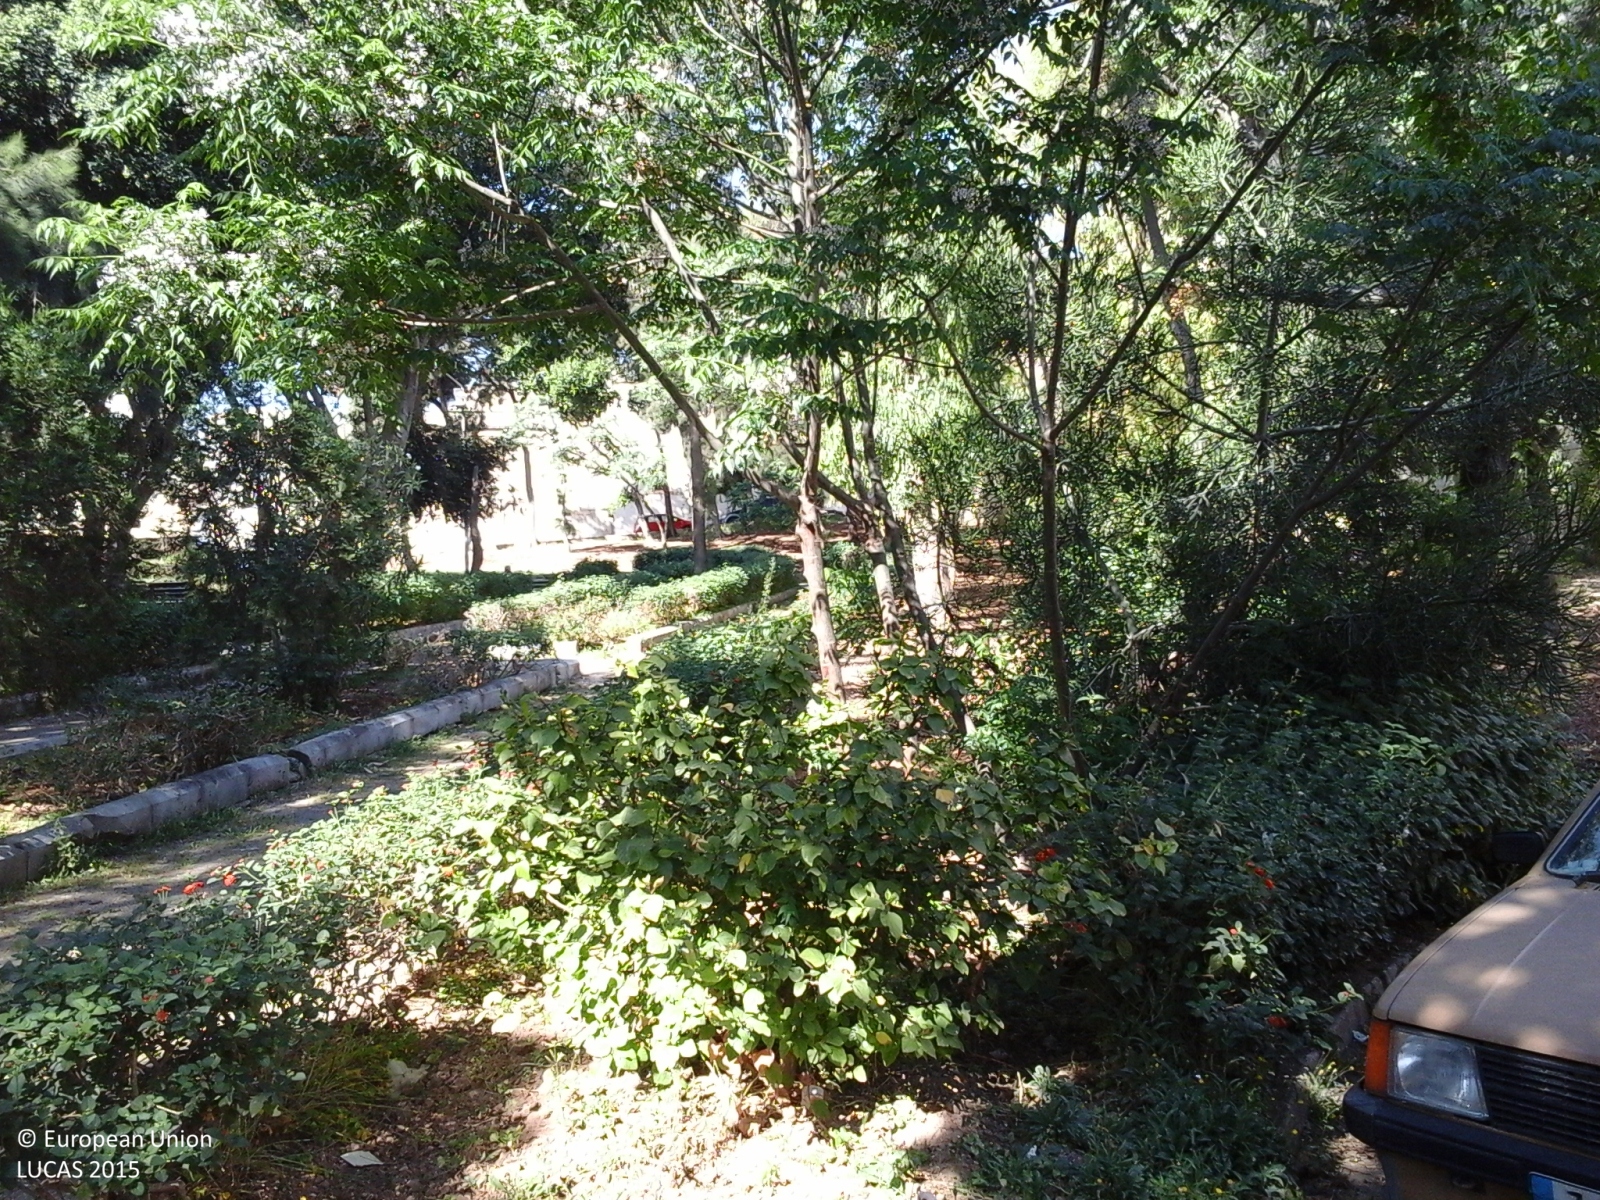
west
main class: Woodland
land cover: Pine dominated coniferous woodland
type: coniferous forest of the mediterranean region
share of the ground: 50 - 75 %
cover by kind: coniferous forest trees 100 %
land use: Amenities, museums, leisure
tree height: > 5 m
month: May
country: MT
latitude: 35.8753
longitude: 14.5105
